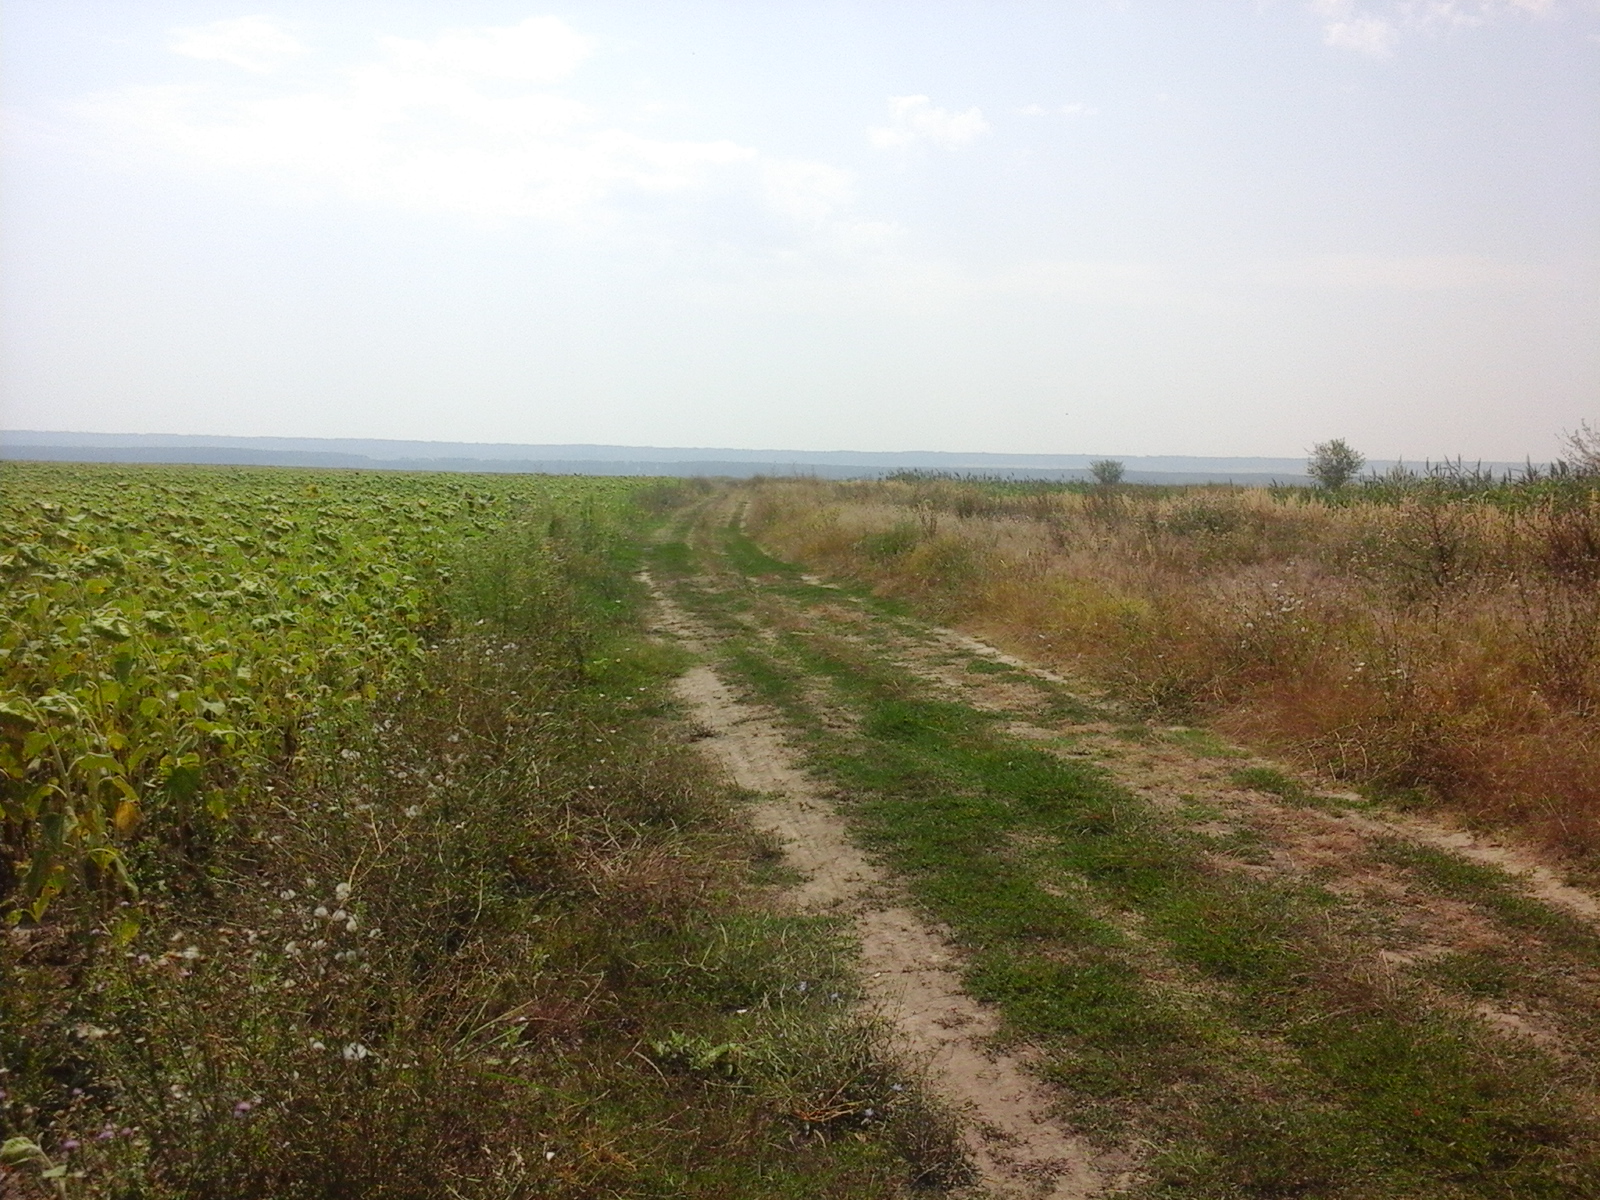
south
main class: Cropland
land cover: Sunflower
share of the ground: > 75 %
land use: Agriculture (excluding fallow land and kitchen gardens)
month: August
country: RO
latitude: 43.8851
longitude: 23.3515
